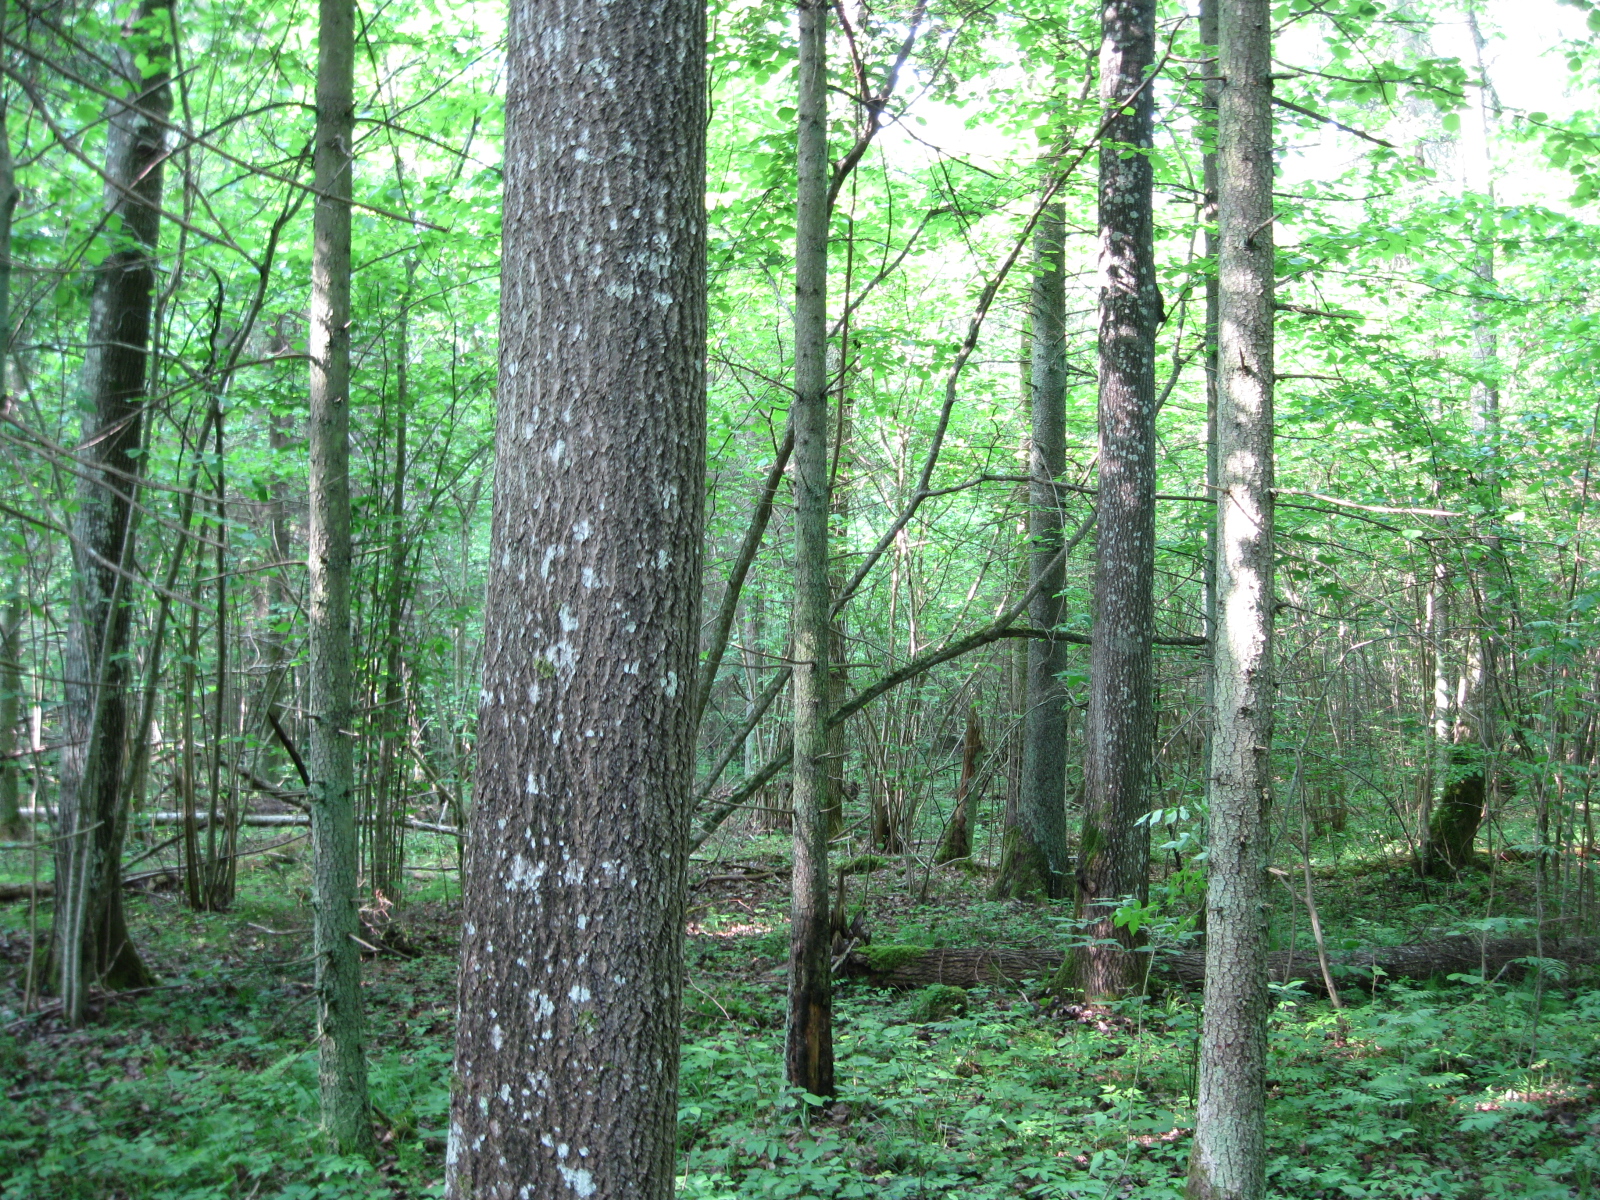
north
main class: Woodland
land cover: Spruce dominated mixed woodland
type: hemiboreal forest and nemoral coniferous forest and mixed broadleaved-coniferous forest
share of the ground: > 75 %
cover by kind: broadleaved forest trees 50 %, coniferous forest trees 35 %, herbaceous plants 10 %, shrubs 5 %
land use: Forestry
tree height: > 5 m
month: June
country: LT
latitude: 55.9412
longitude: 23.8698
